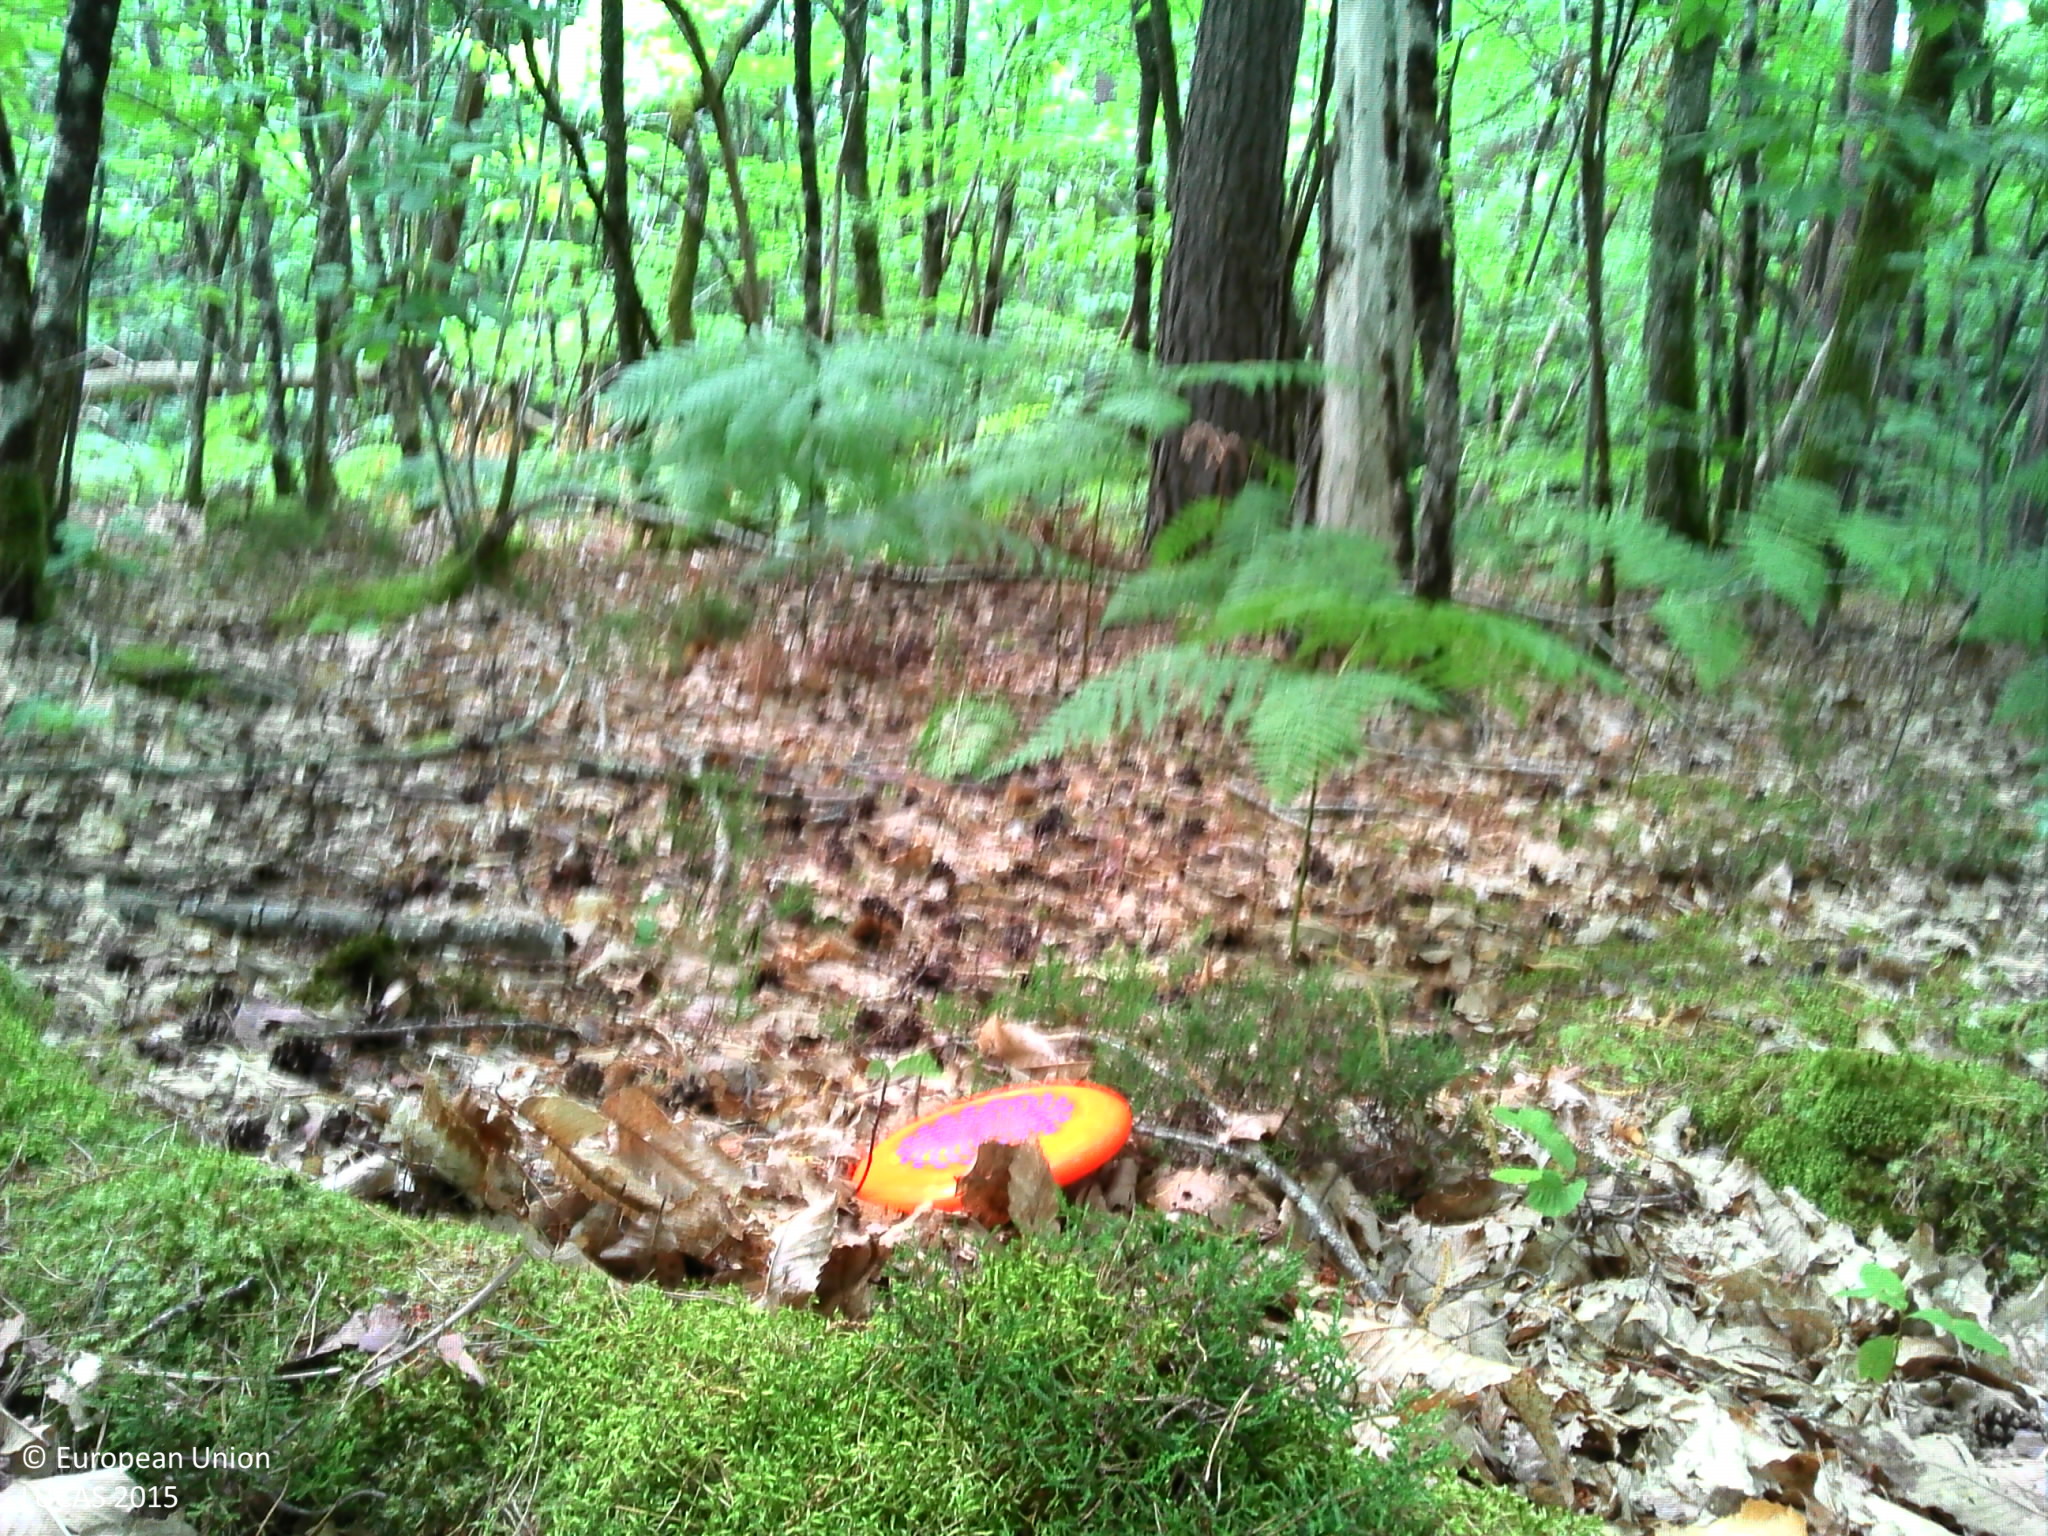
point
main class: Woodland
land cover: Spruce dominated mixed woodland
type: hemiboreal forest and nemoral coniferous forest and mixed broadleaved-coniferous forest
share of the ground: > 75 %
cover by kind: broadleaved forest trees 45 %, lichens and mosses 25 %, coniferous forest trees 15 %, herbaceous plants 15 %
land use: Forestry
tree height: > 5 m
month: July
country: FR
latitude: 45.7051
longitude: 0.6493
